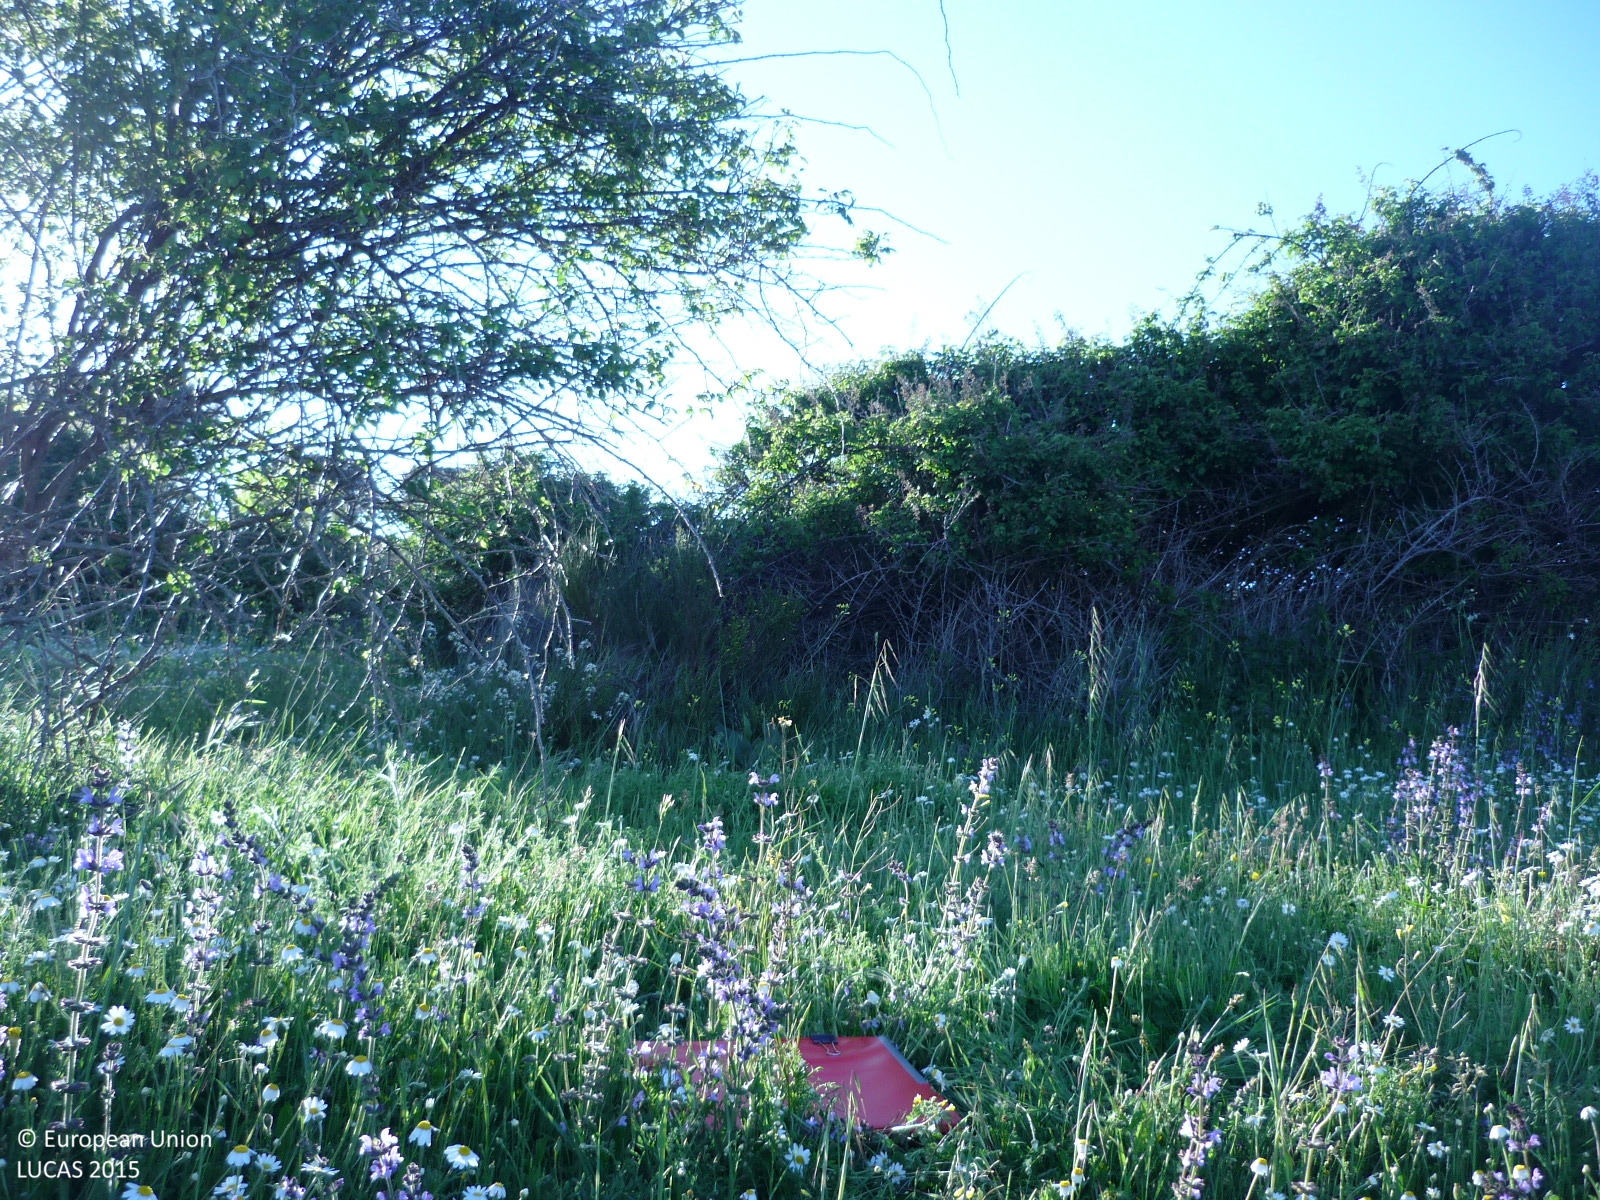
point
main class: Grassland
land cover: Grassland with sparse tree/shrub cover
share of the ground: > 75 %
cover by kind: herbaceous plants 85 %, broadleaved forest trees 5 %, shrubs 5 %, unconsolidated bare surface 5 %
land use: Agriculture (excluding fallow land and kitchen gardens)
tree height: < 5 m
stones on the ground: < 10 %
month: May
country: ES
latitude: 40.9392
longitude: -3.6432
